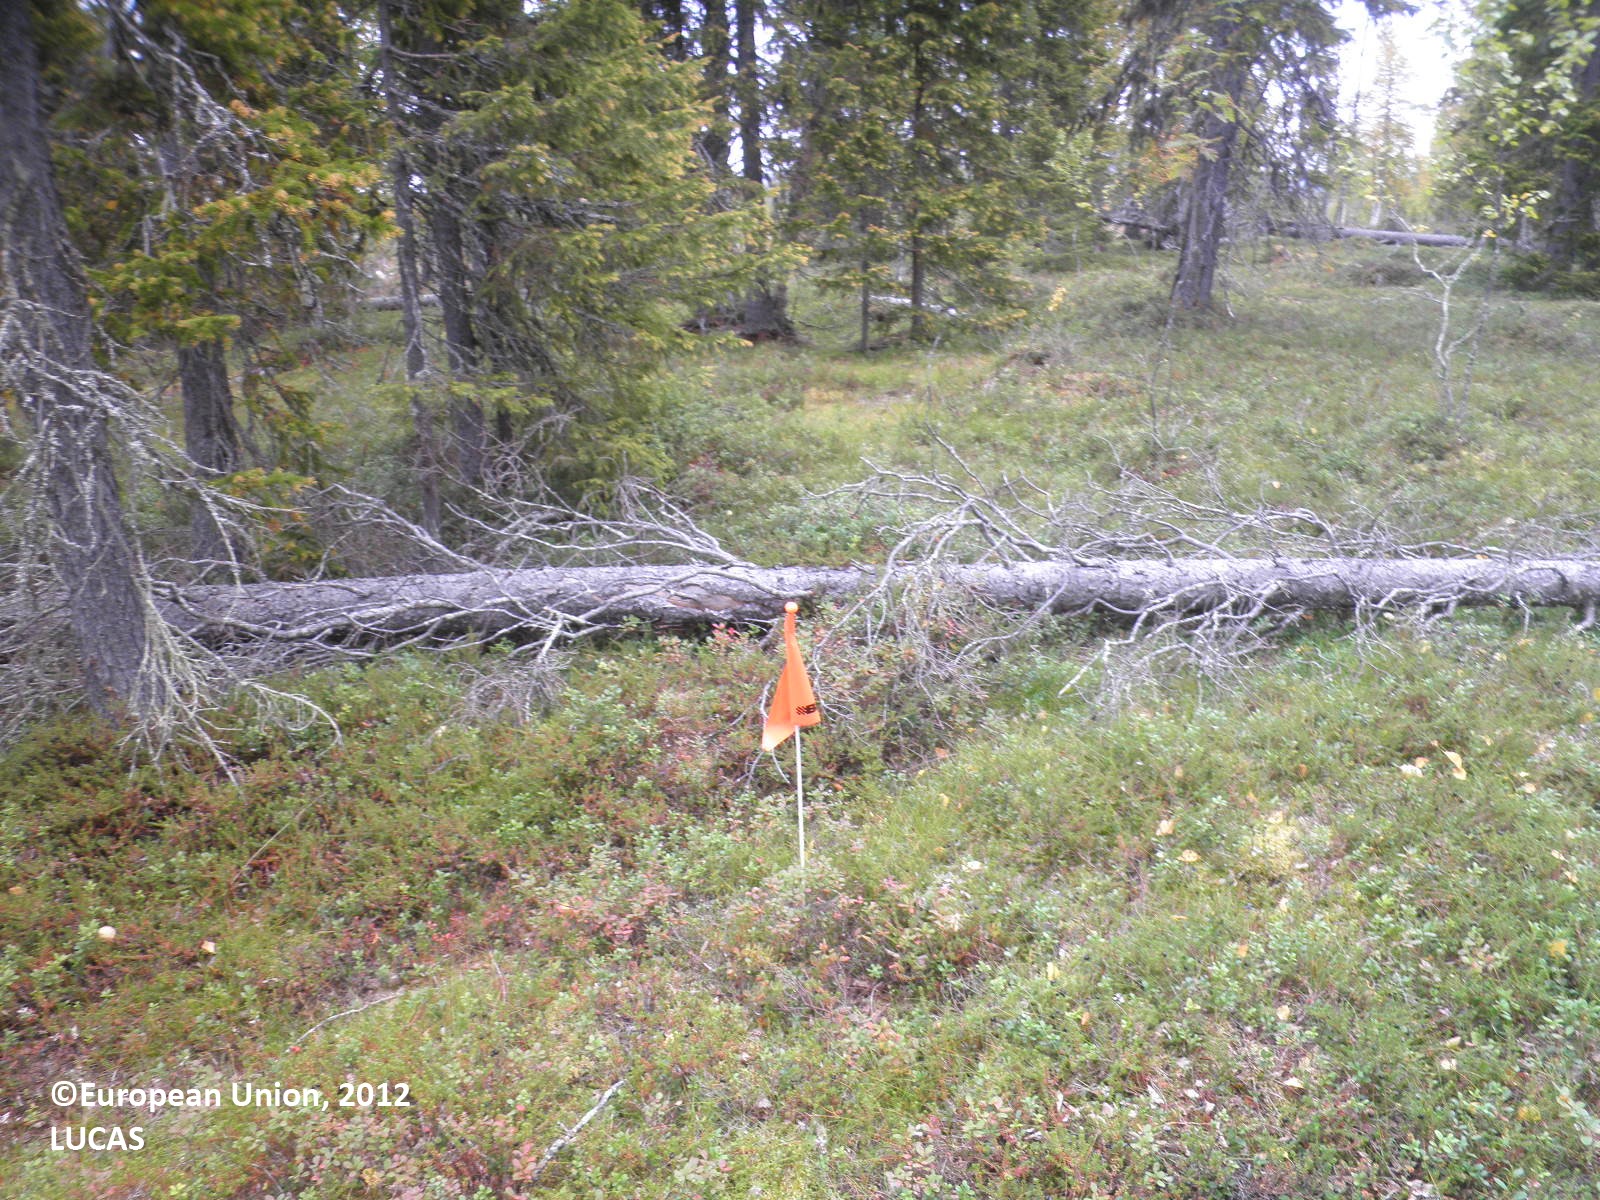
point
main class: Woodland
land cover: Spruce dominated mixed woodland
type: boreal forest
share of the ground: 50 - 75 %
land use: Forestry
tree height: > 5 m
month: August
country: FI
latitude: 67.5787
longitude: 27.9900
